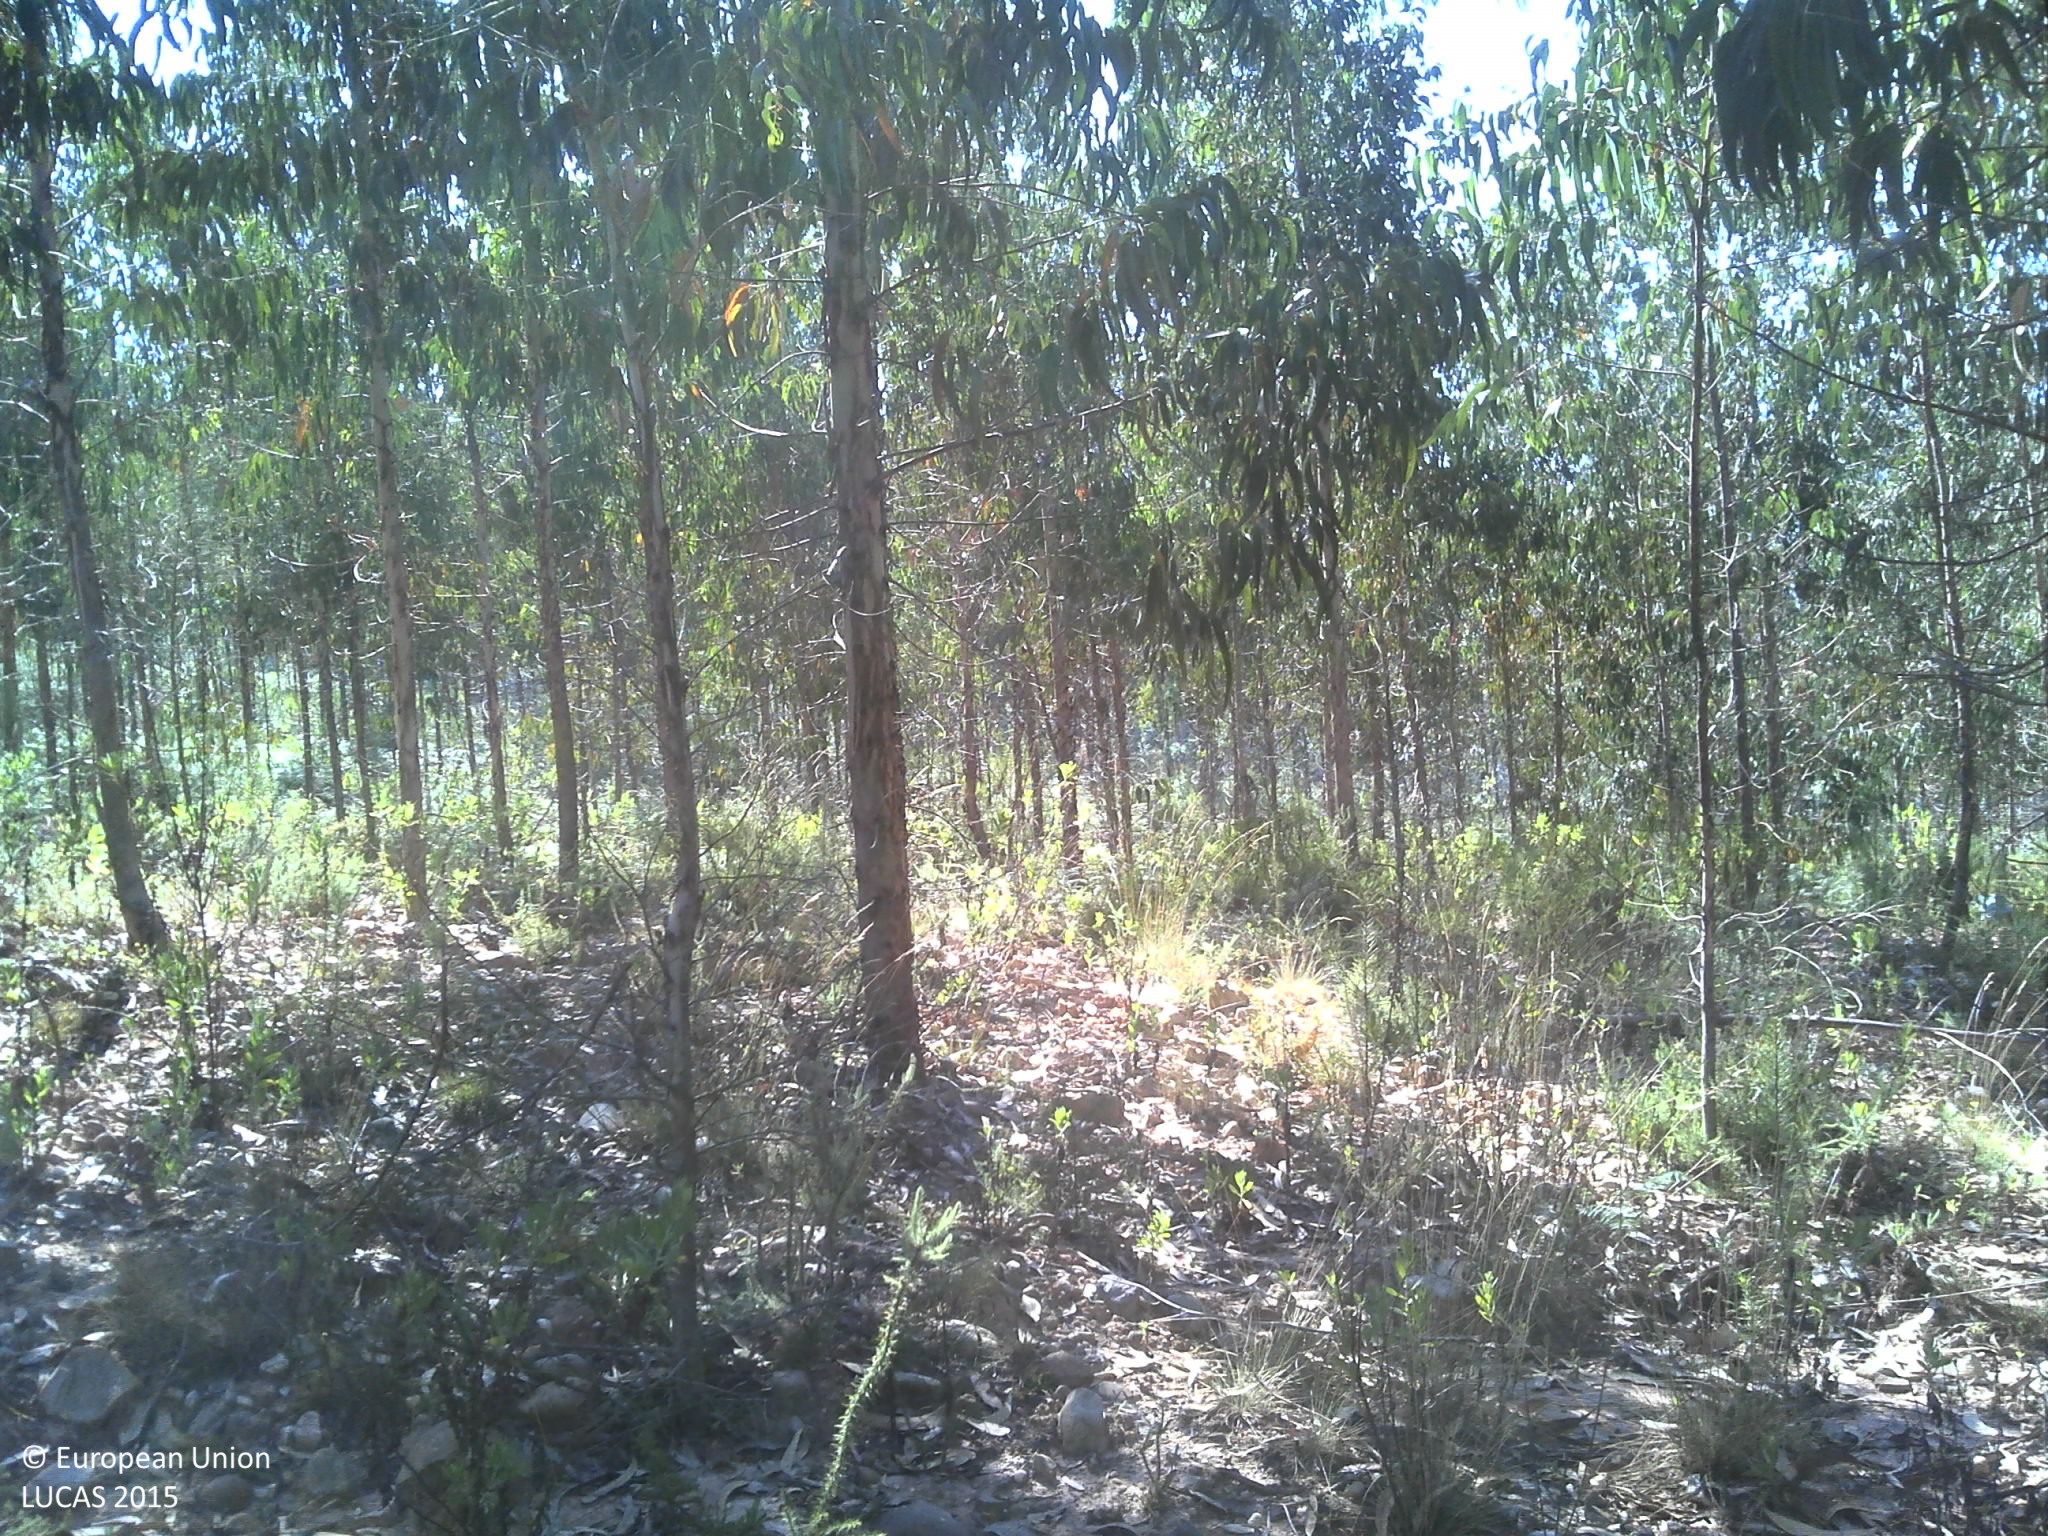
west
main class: Woodland
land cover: Broadleaved woodland
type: exotic forest
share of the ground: 50 - 75 %
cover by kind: broadleaved forest trees 60 %, unconsolidated bare surface 25 %, shrubs 15 %
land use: Forestry
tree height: > 5 m
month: June
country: PT
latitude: 39.6944
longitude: -8.8735
